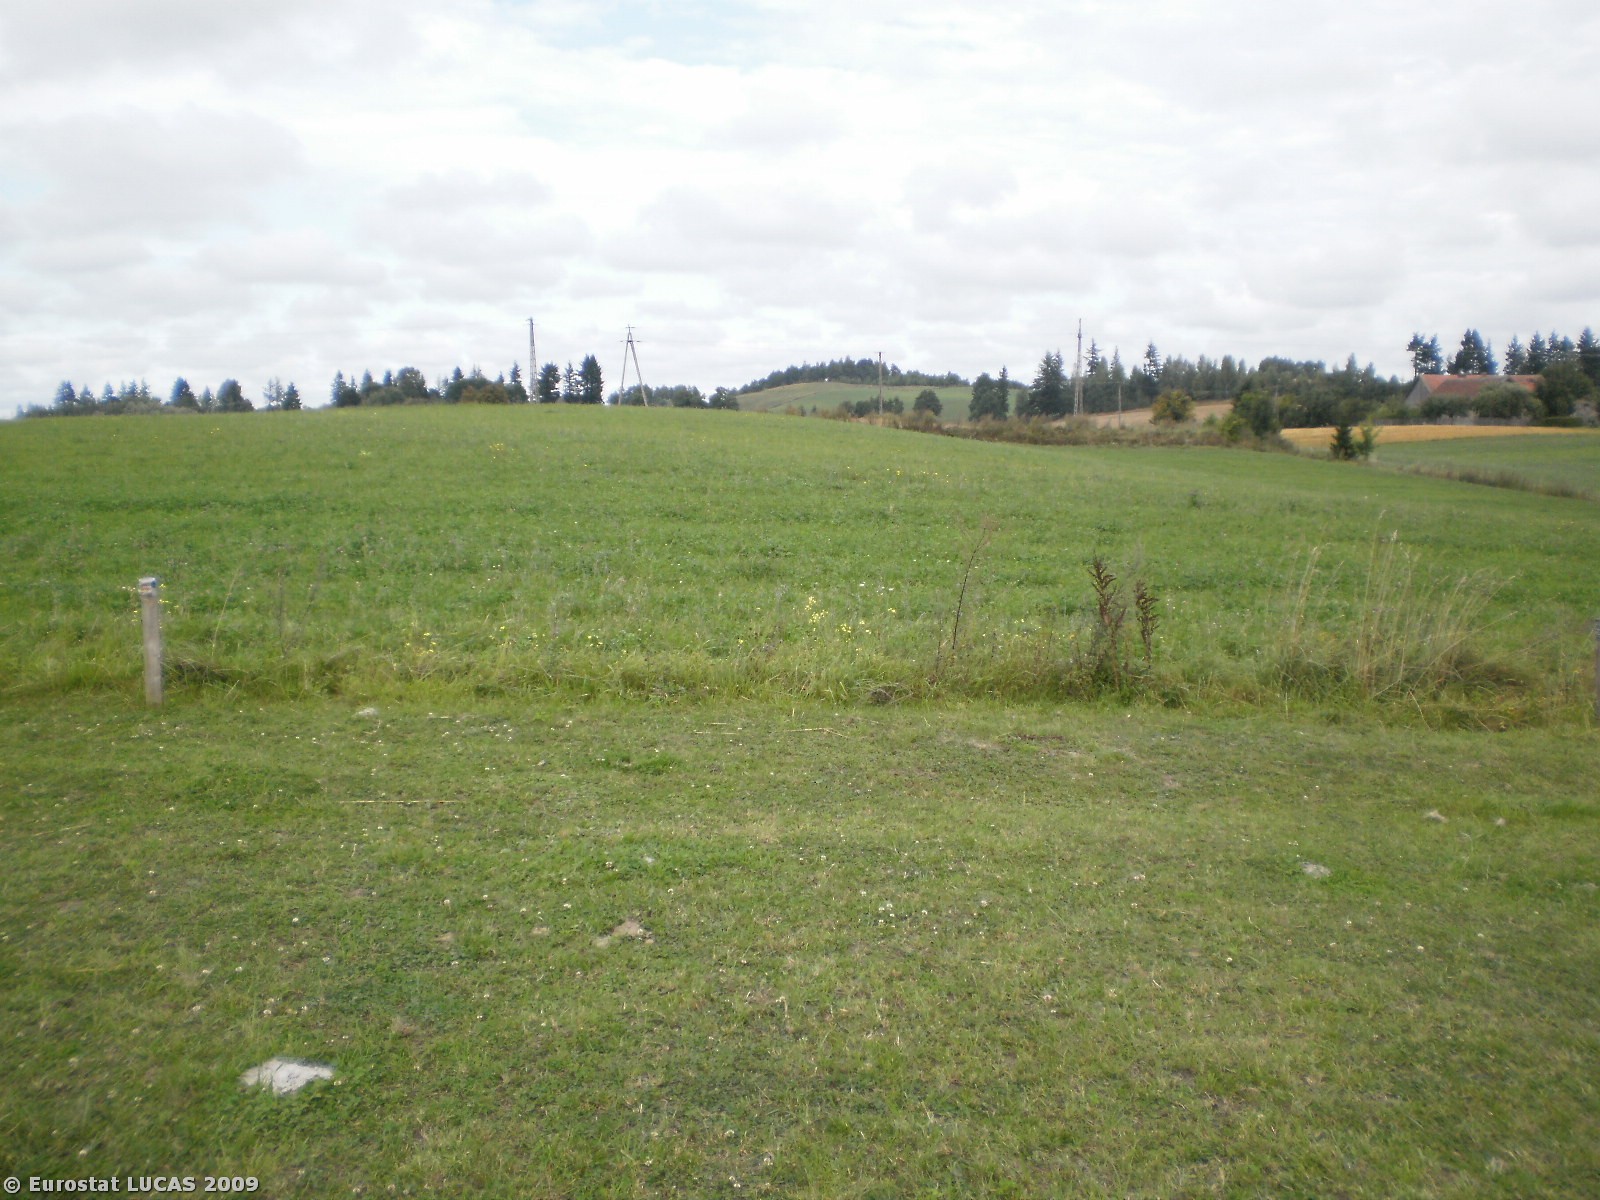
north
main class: Grassland
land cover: Grassland without tree/shrub cover
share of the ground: > 75 %
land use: Agriculture (excluding fallow land and kitchen gardens)
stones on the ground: < 10 %
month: August
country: PL
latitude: 54.0468
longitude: 22.1086
